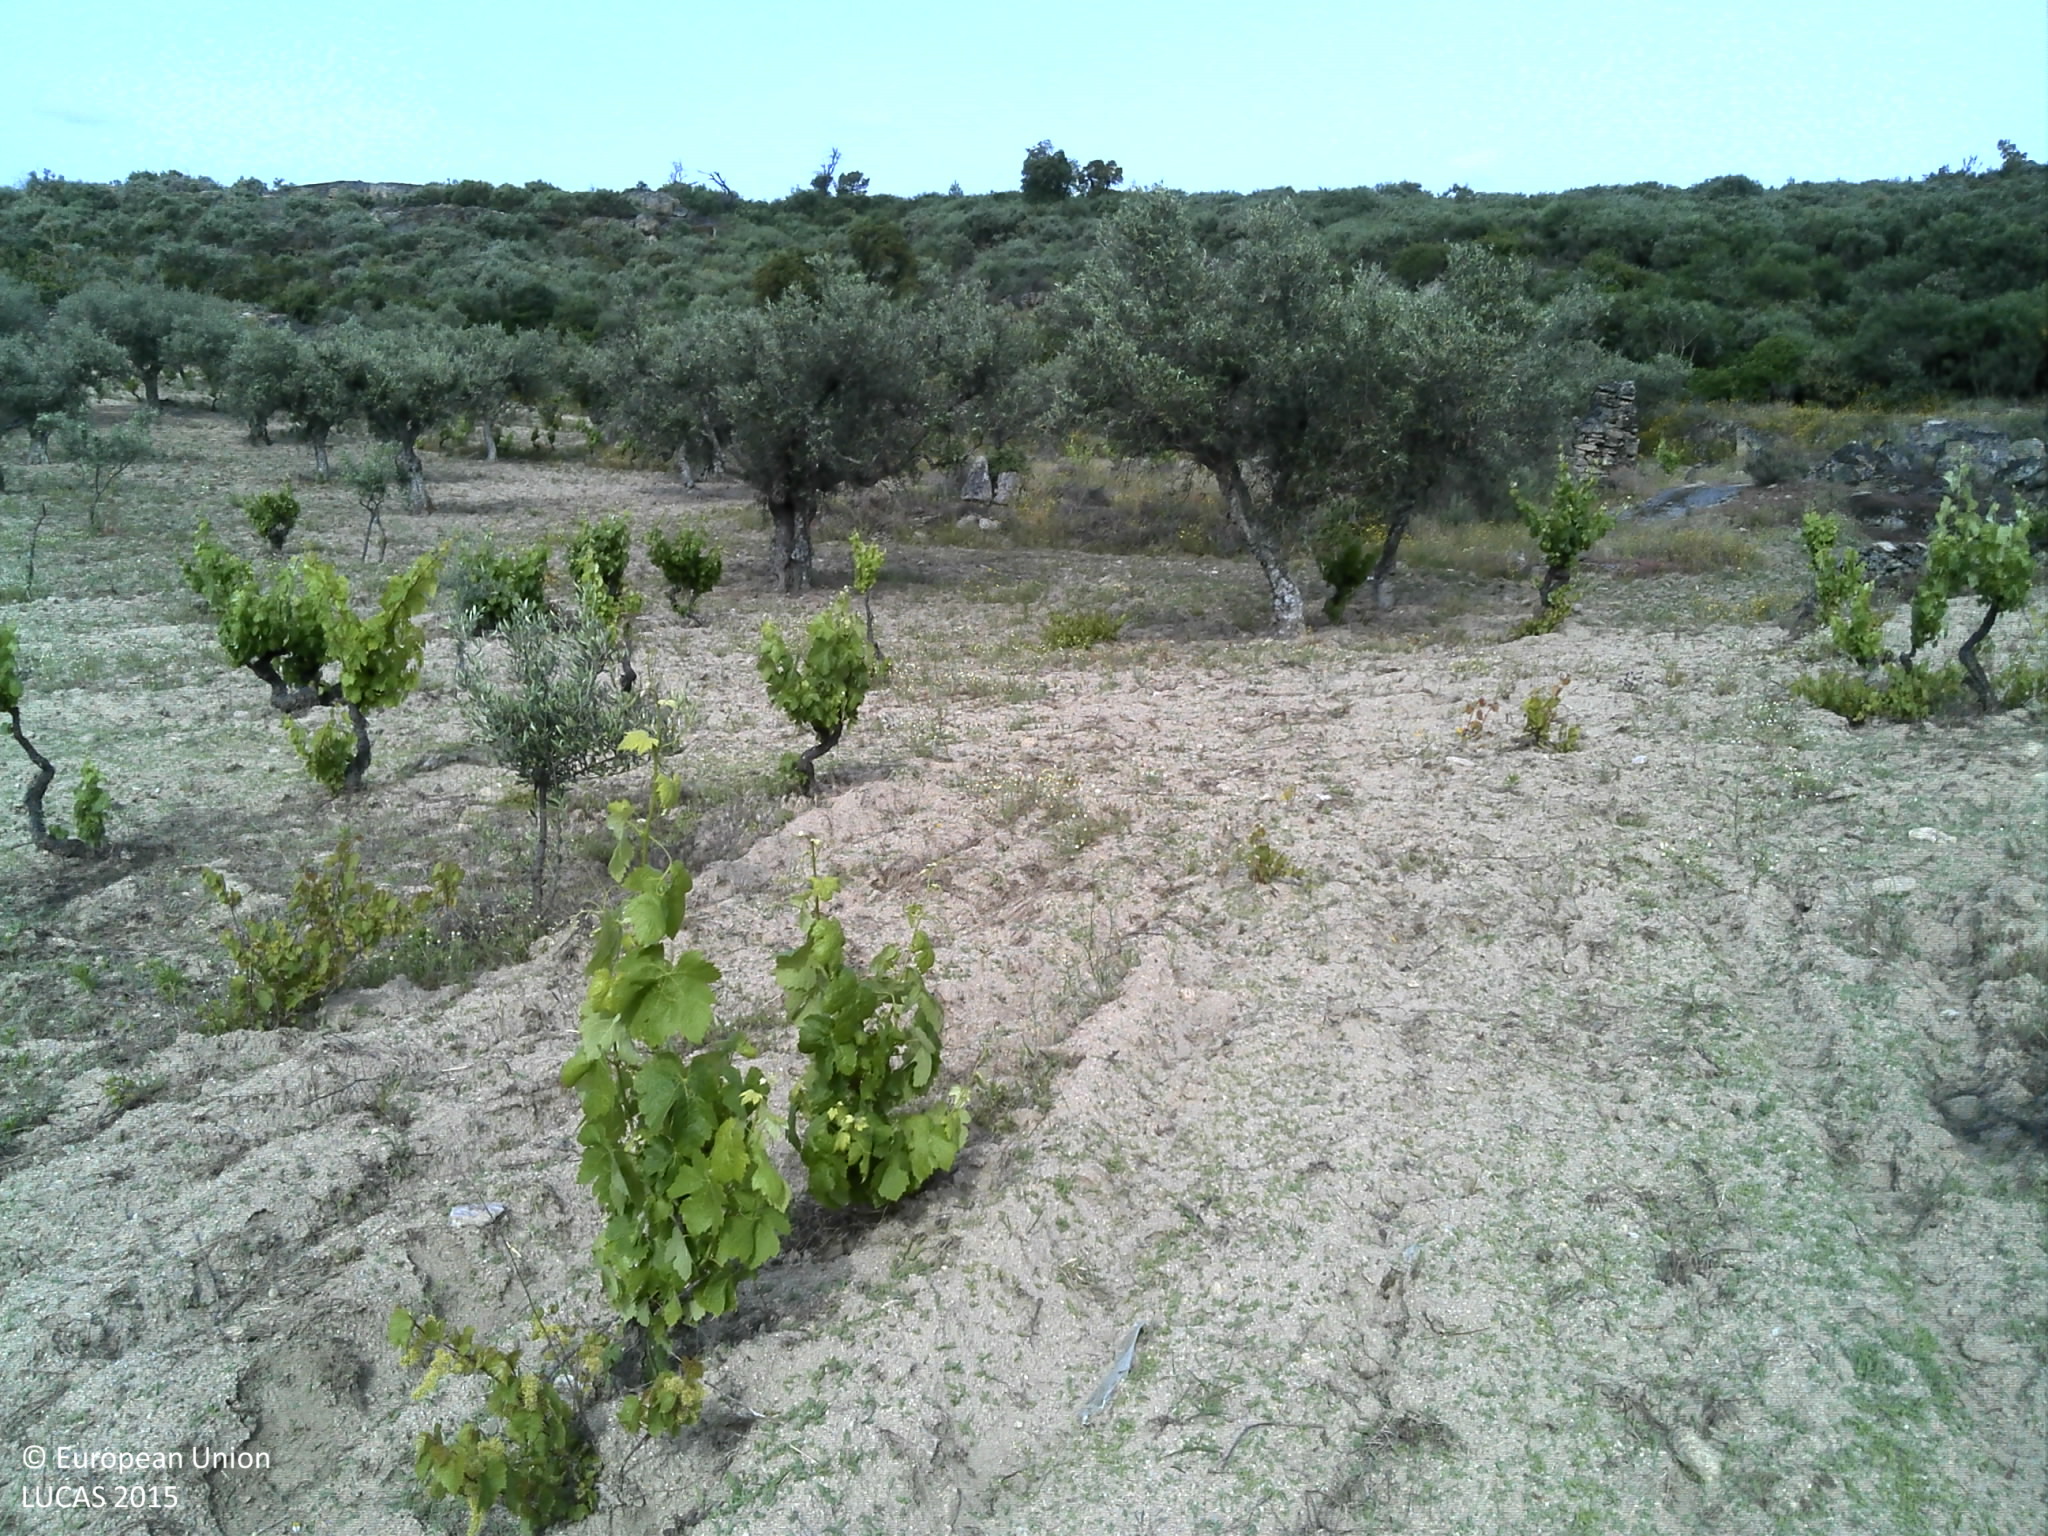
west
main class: Cropland
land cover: Vineyards
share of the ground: < 10 %
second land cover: Olive groves
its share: < 10 %
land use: Agriculture (excluding fallow land and kitchen gardens)
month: May
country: PT
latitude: 41.5783
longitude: -7.2862
